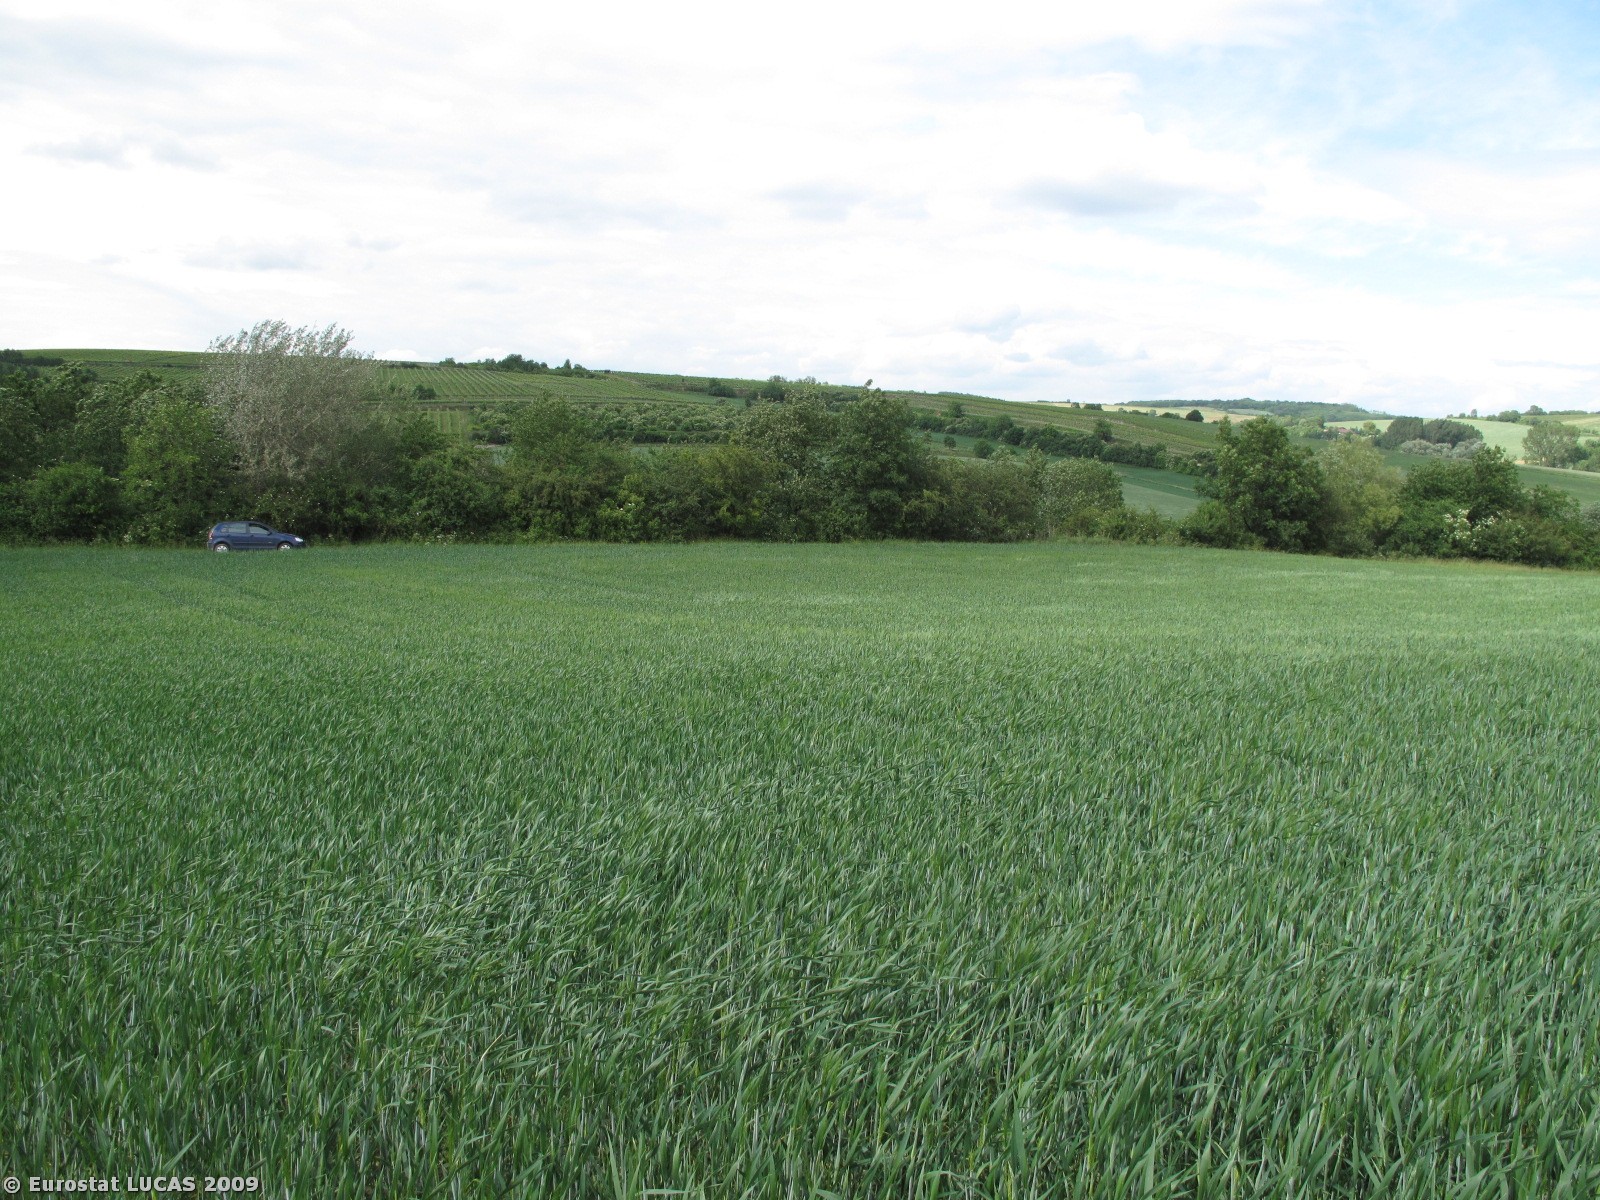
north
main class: Cropland
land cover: Common wheat
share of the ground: > 75 %
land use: Agriculture (excluding fallow land and kitchen gardens)
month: May
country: AT
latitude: 48.4753
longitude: 15.9967
